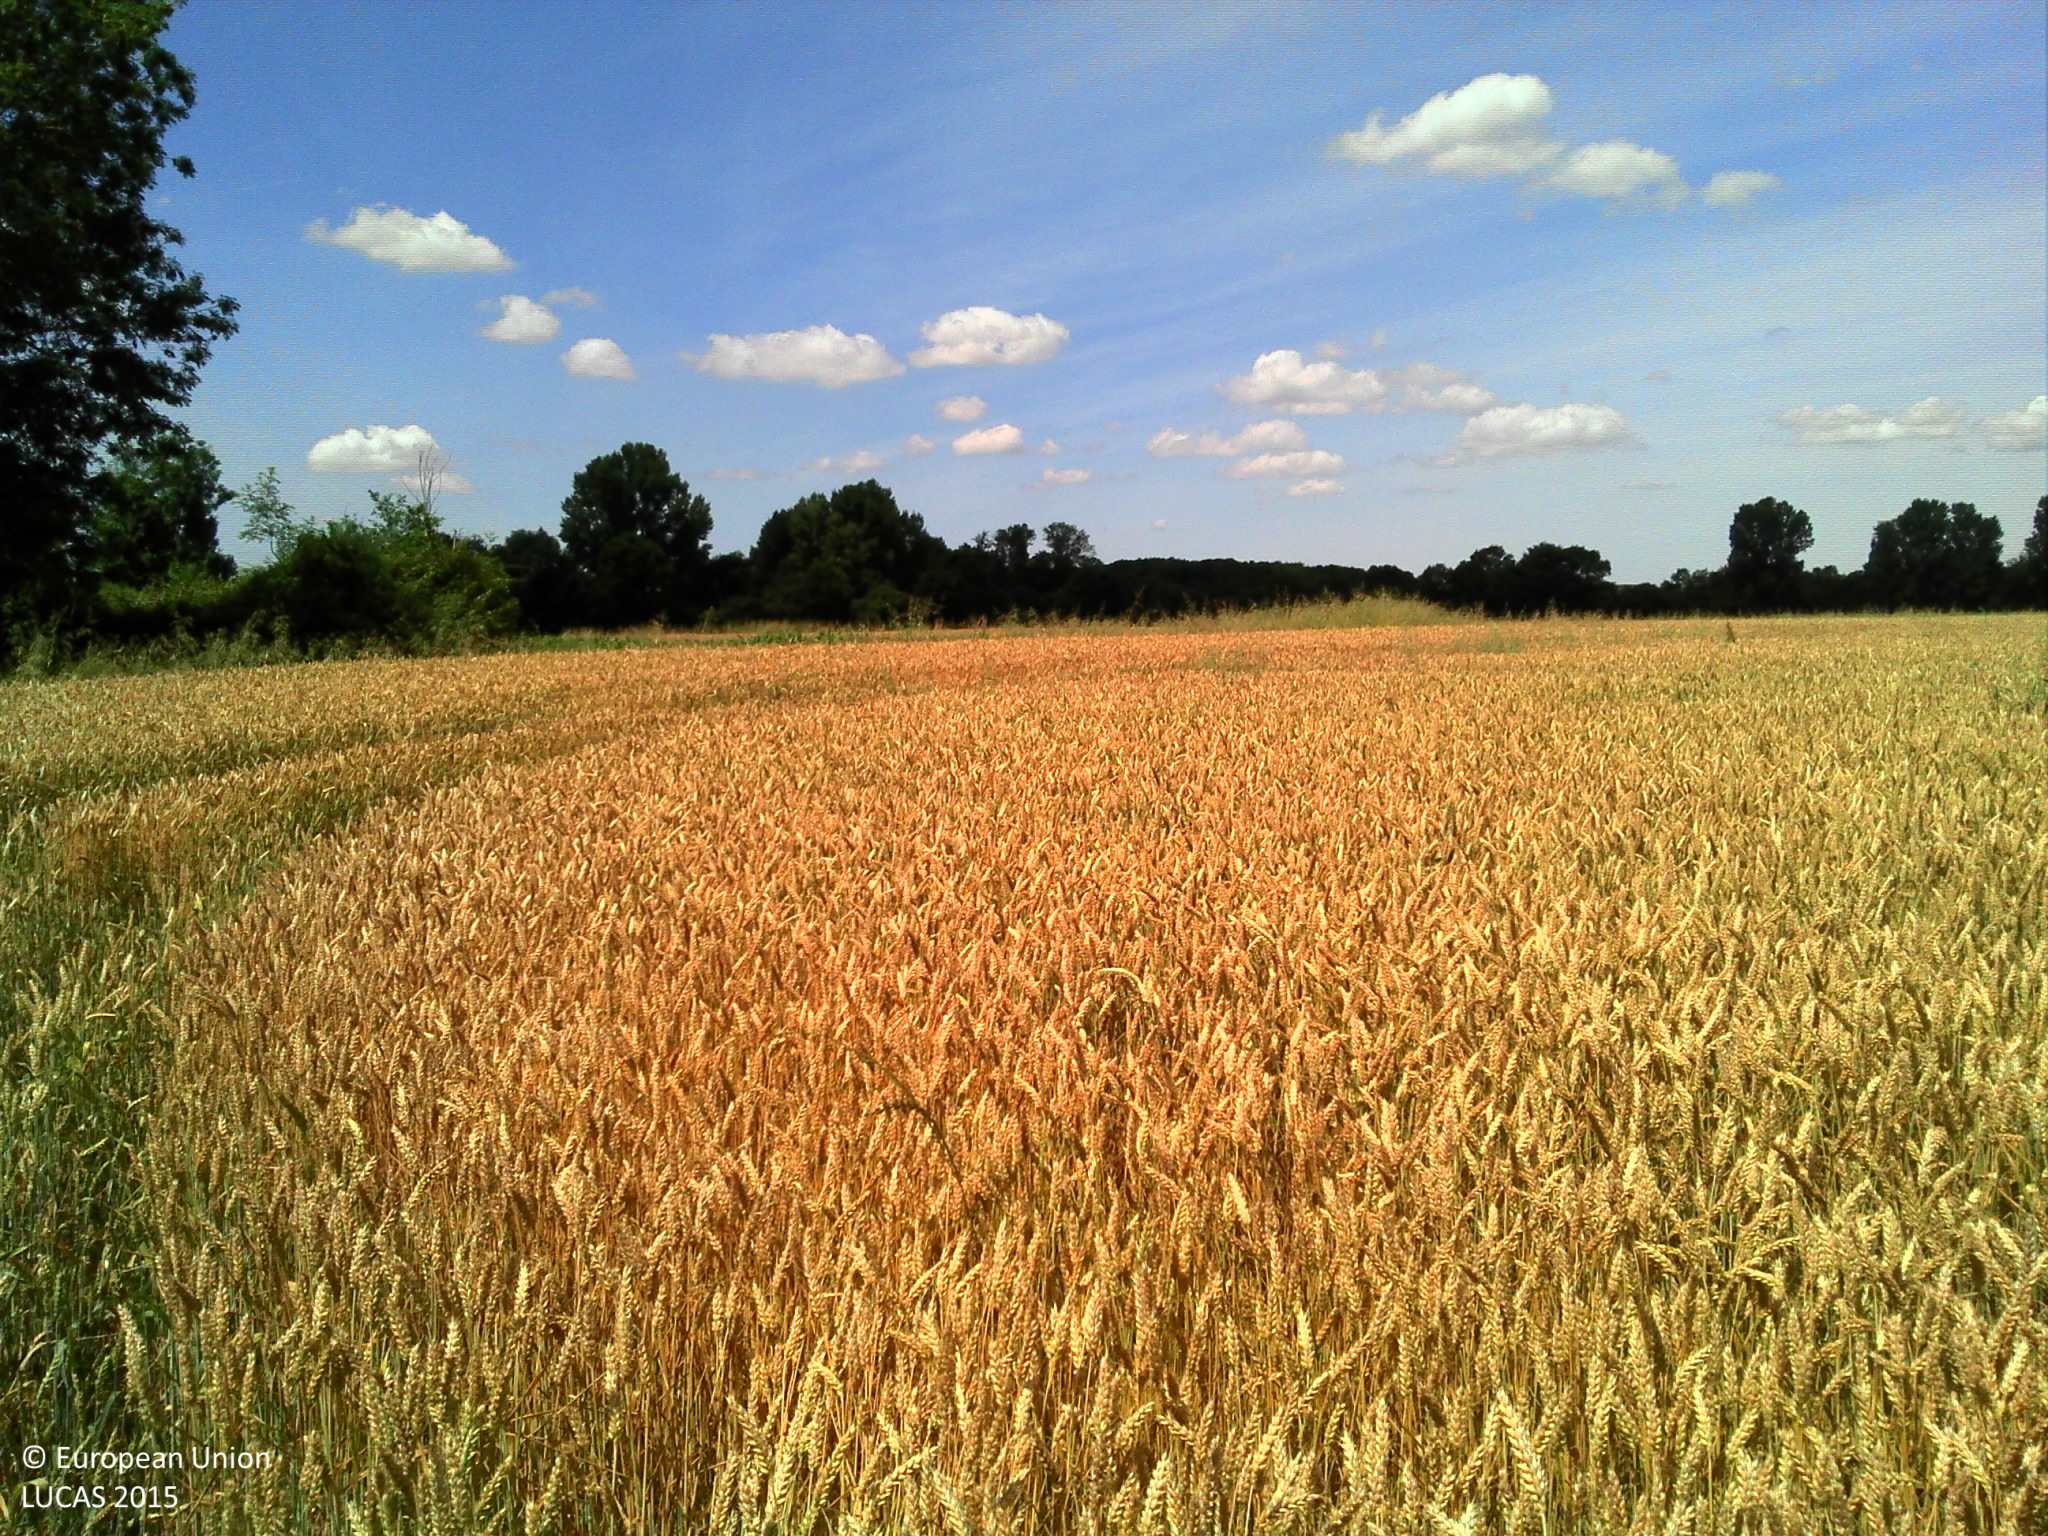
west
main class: Cropland
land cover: Common wheat
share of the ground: > 75 %
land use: Agriculture (excluding fallow land and kitchen gardens)
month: June
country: FR
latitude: 45.7692
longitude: 0.3532
